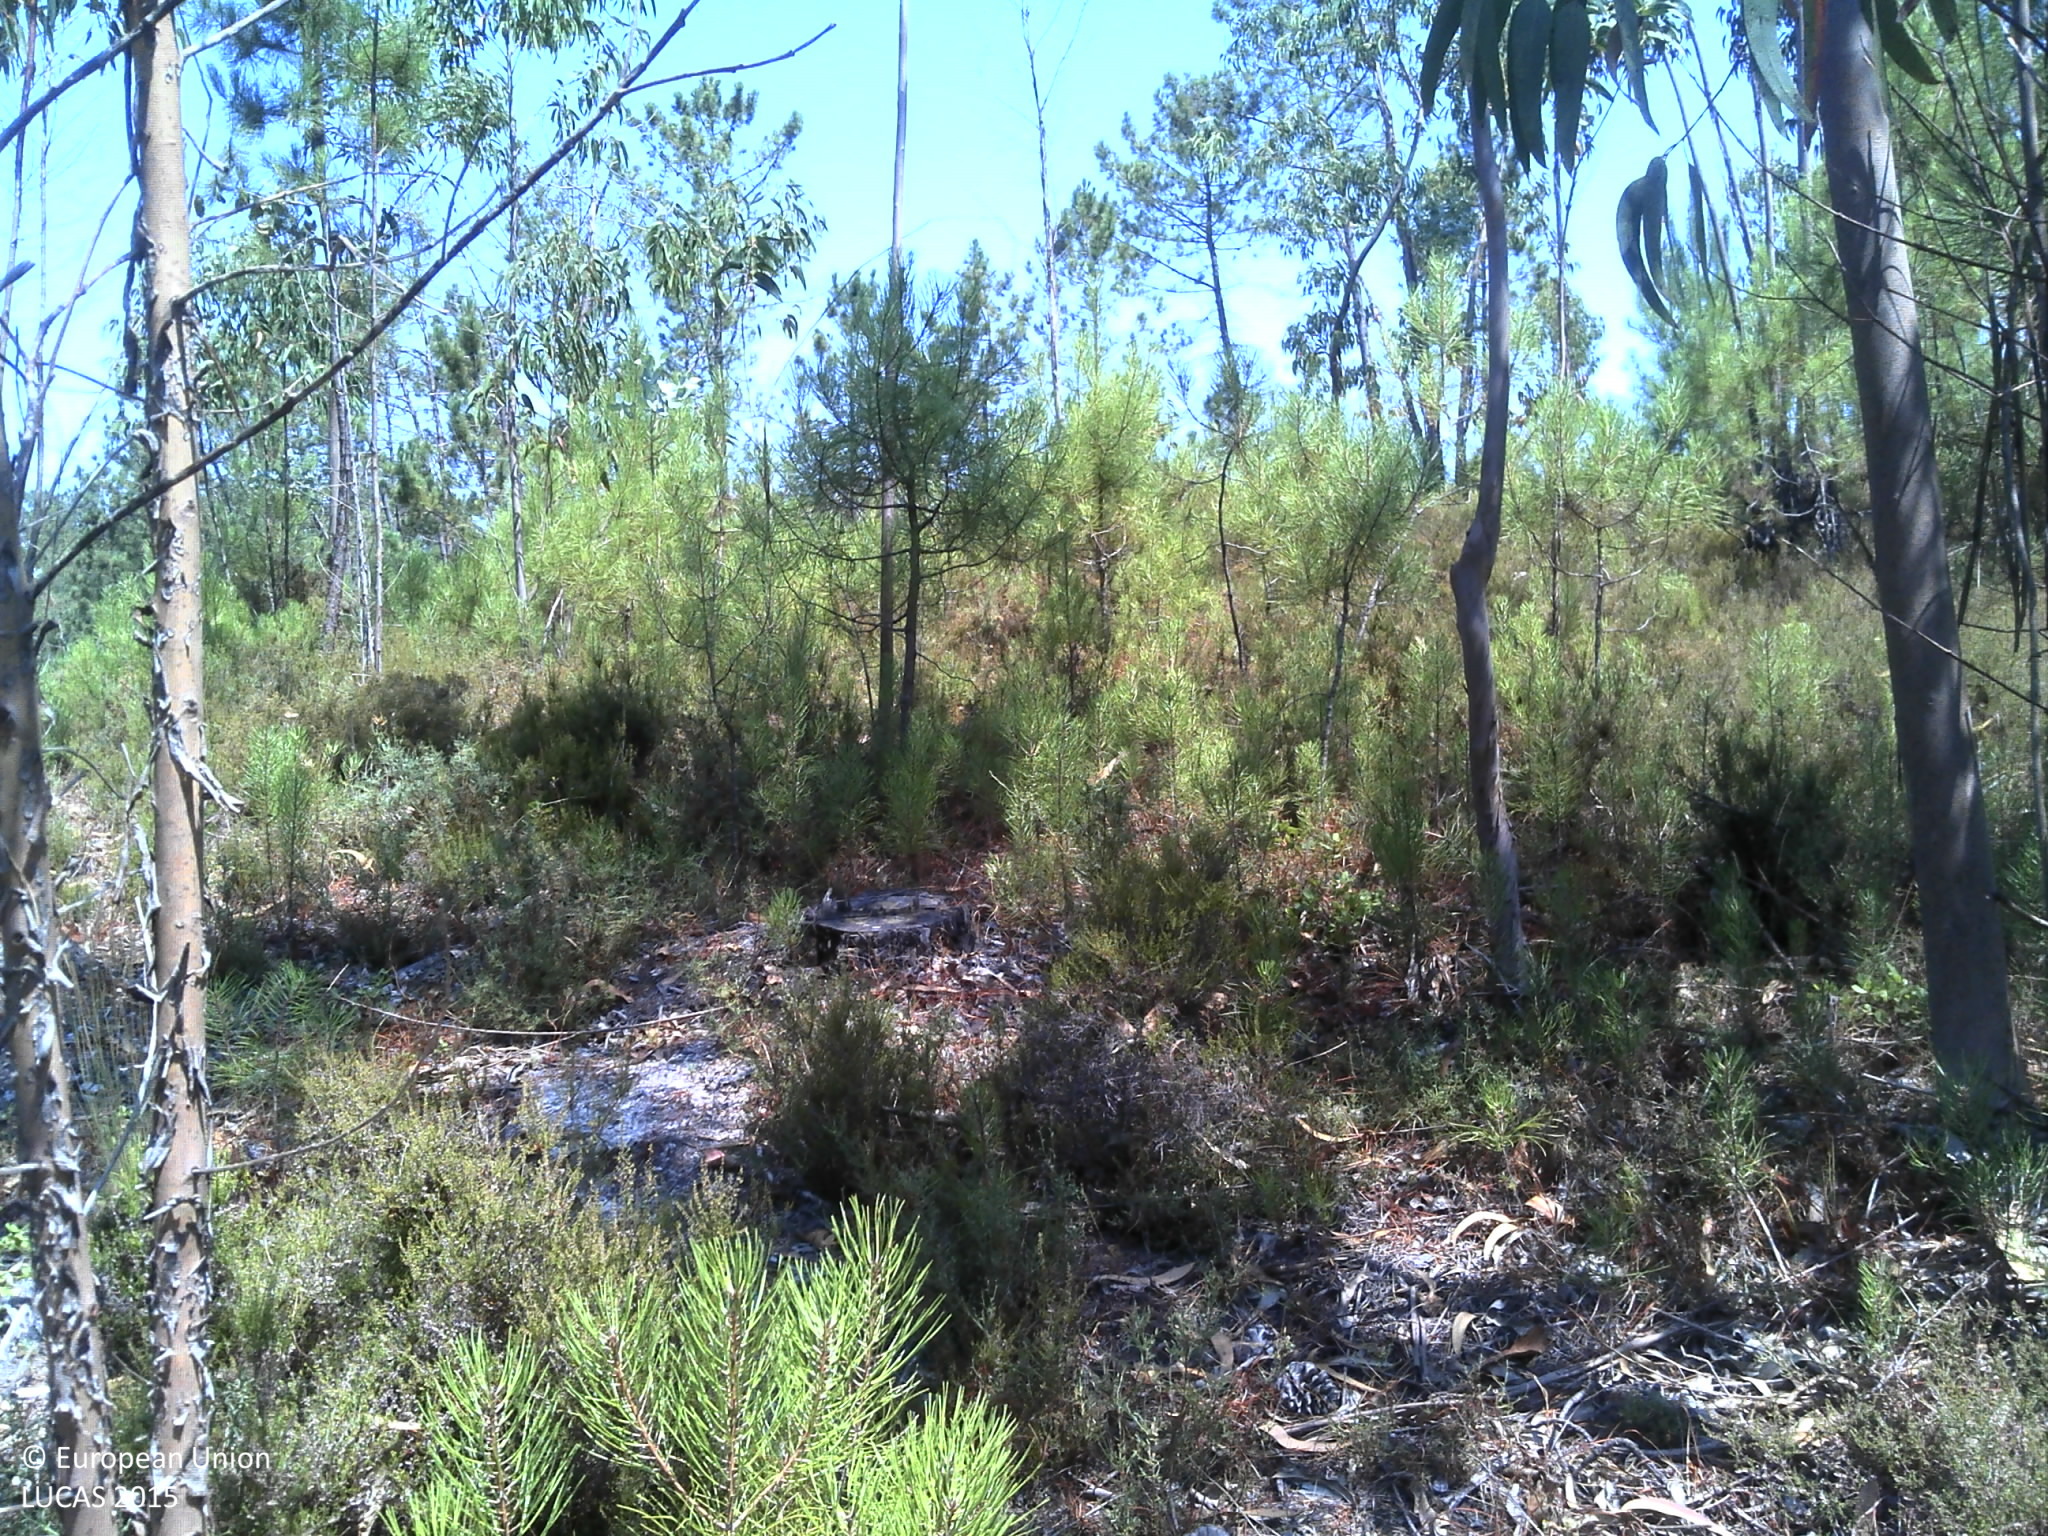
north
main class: Woodland
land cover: Pine dominated mixed woodland
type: coniferous forest of the mediterranean region
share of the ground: 10 - 25 %
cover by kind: shrubs 30 %, unconsolidated bare surface 30 %, coniferous forest trees 20 %, broadleaved forest trees 20 %
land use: Forestry
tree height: > 5 m
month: July
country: PT
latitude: 40.0715
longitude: -8.5523
